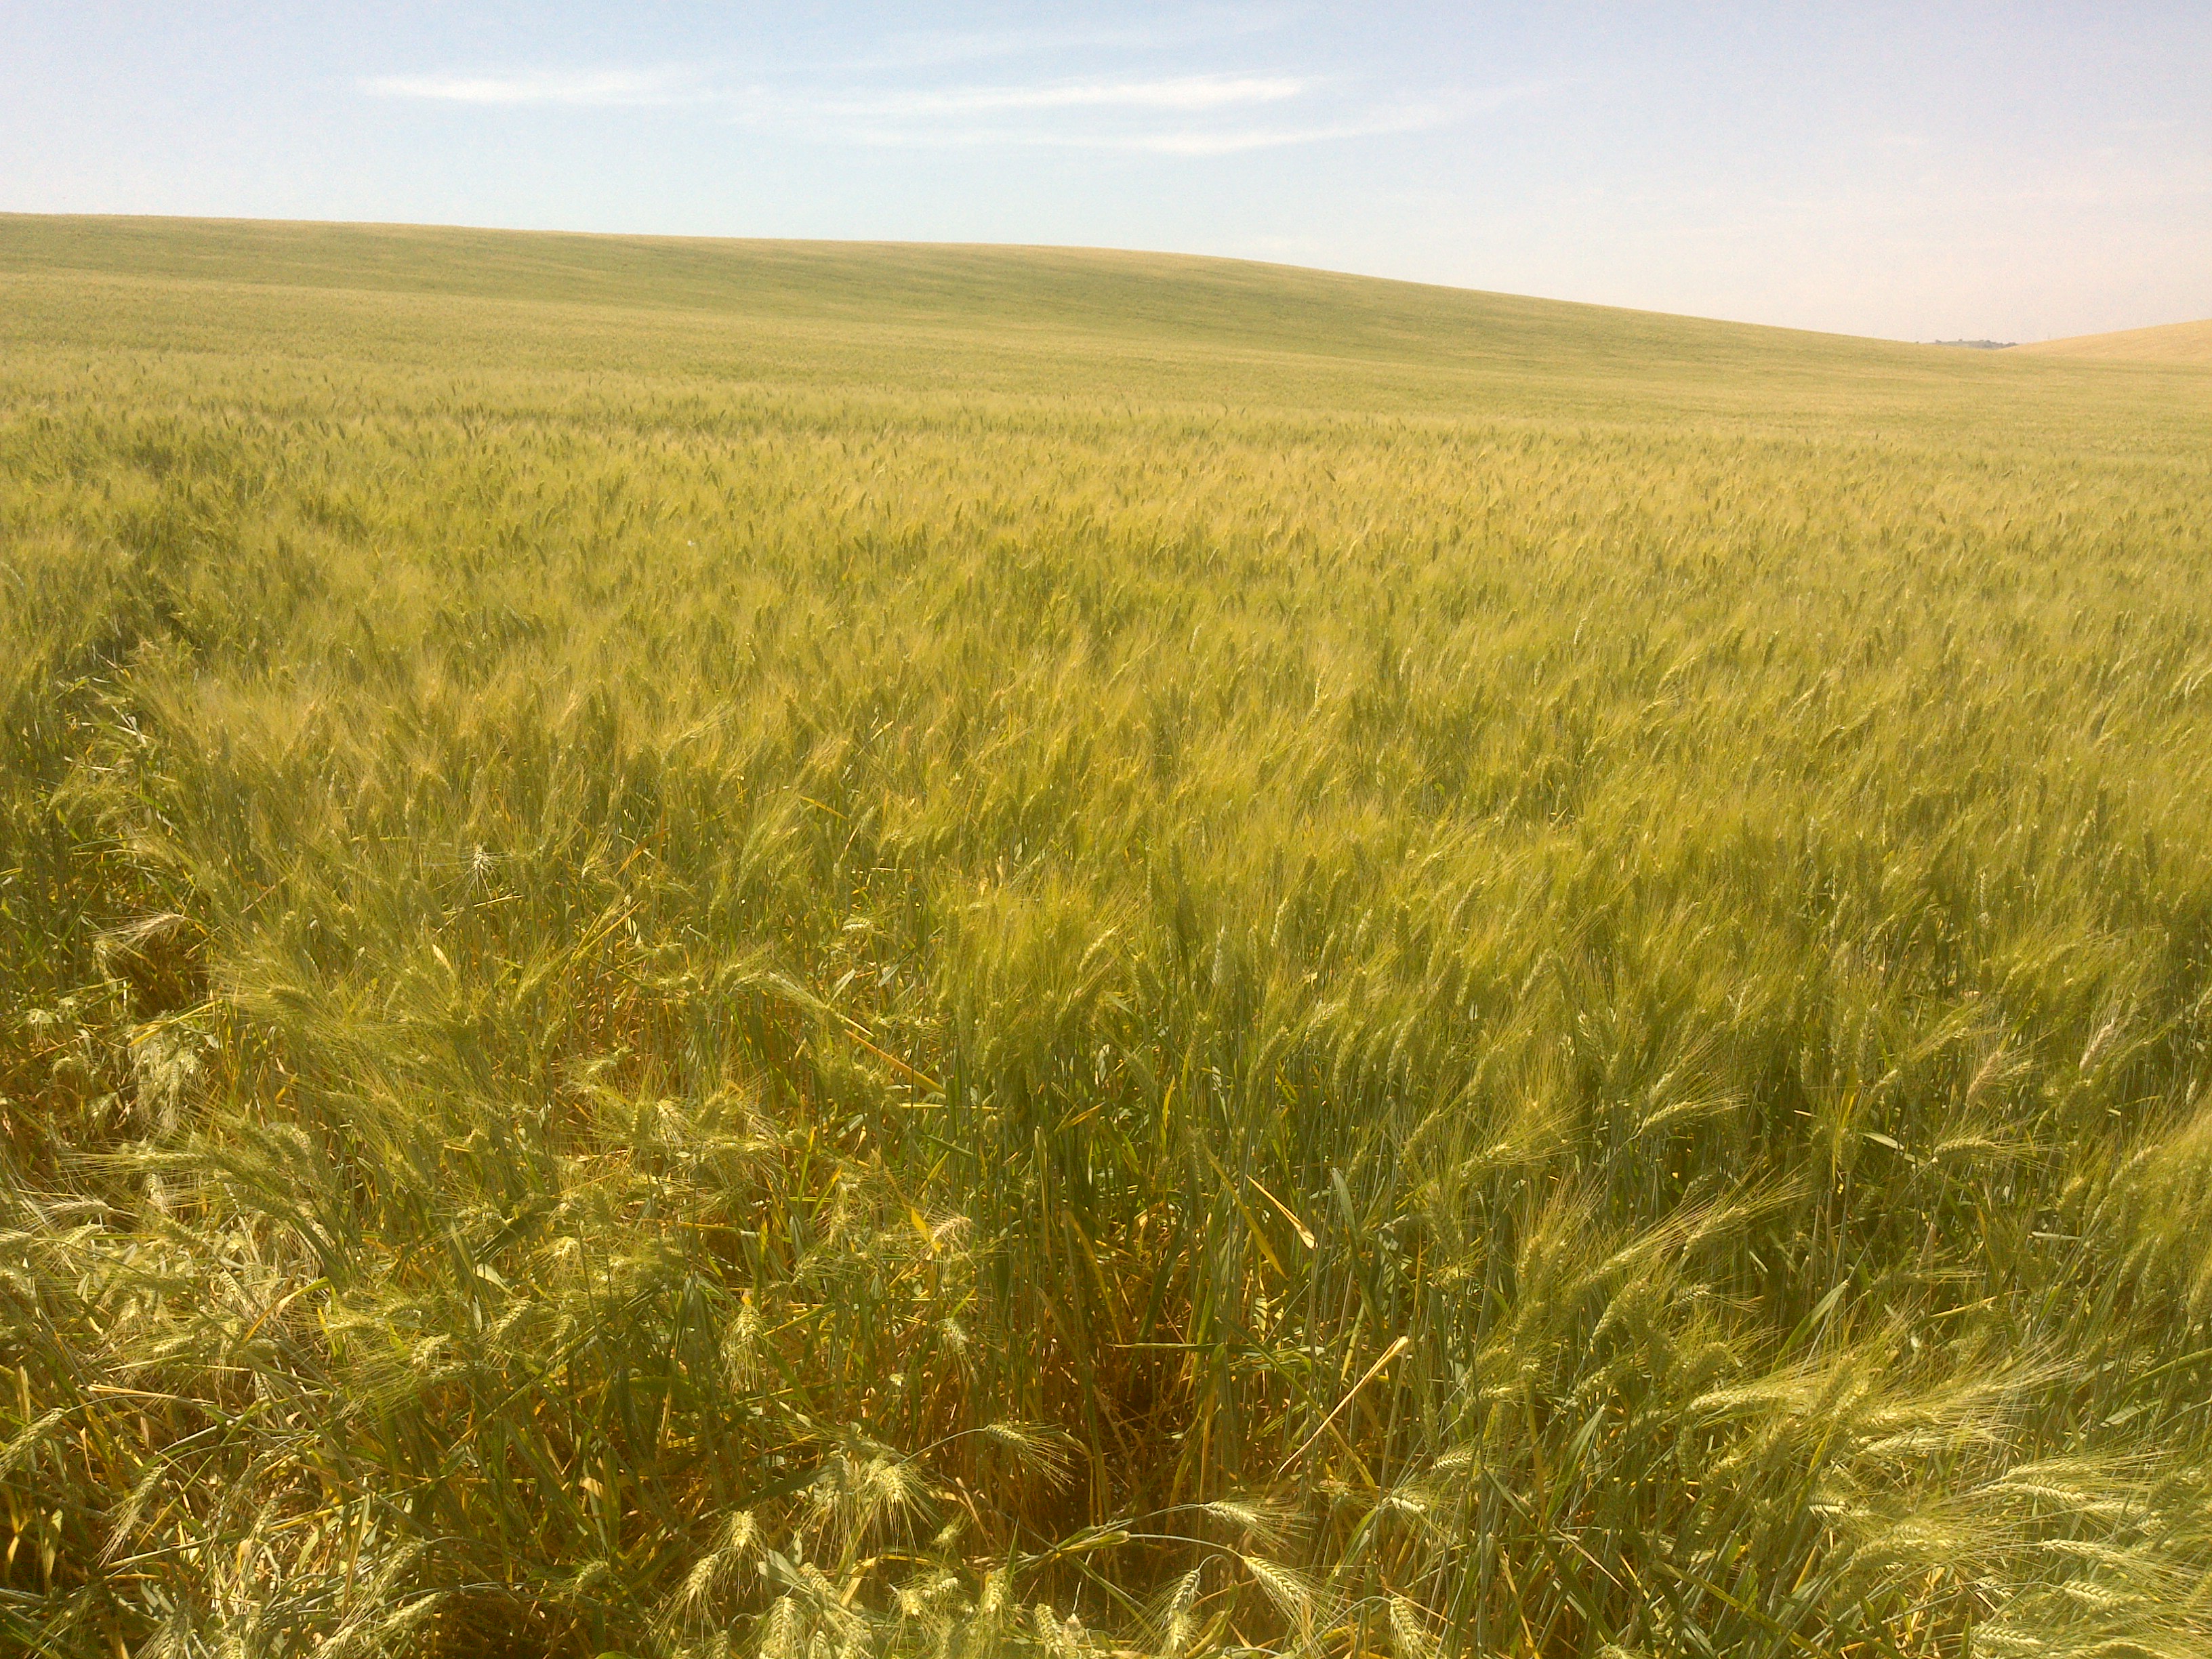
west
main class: Cropland
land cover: Durum wheat
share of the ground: > 75 %
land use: Agriculture (excluding fallow land and kitchen gardens)
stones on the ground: 25 - 50 %
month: May
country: ES
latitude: 37.8331
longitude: -4.5657
